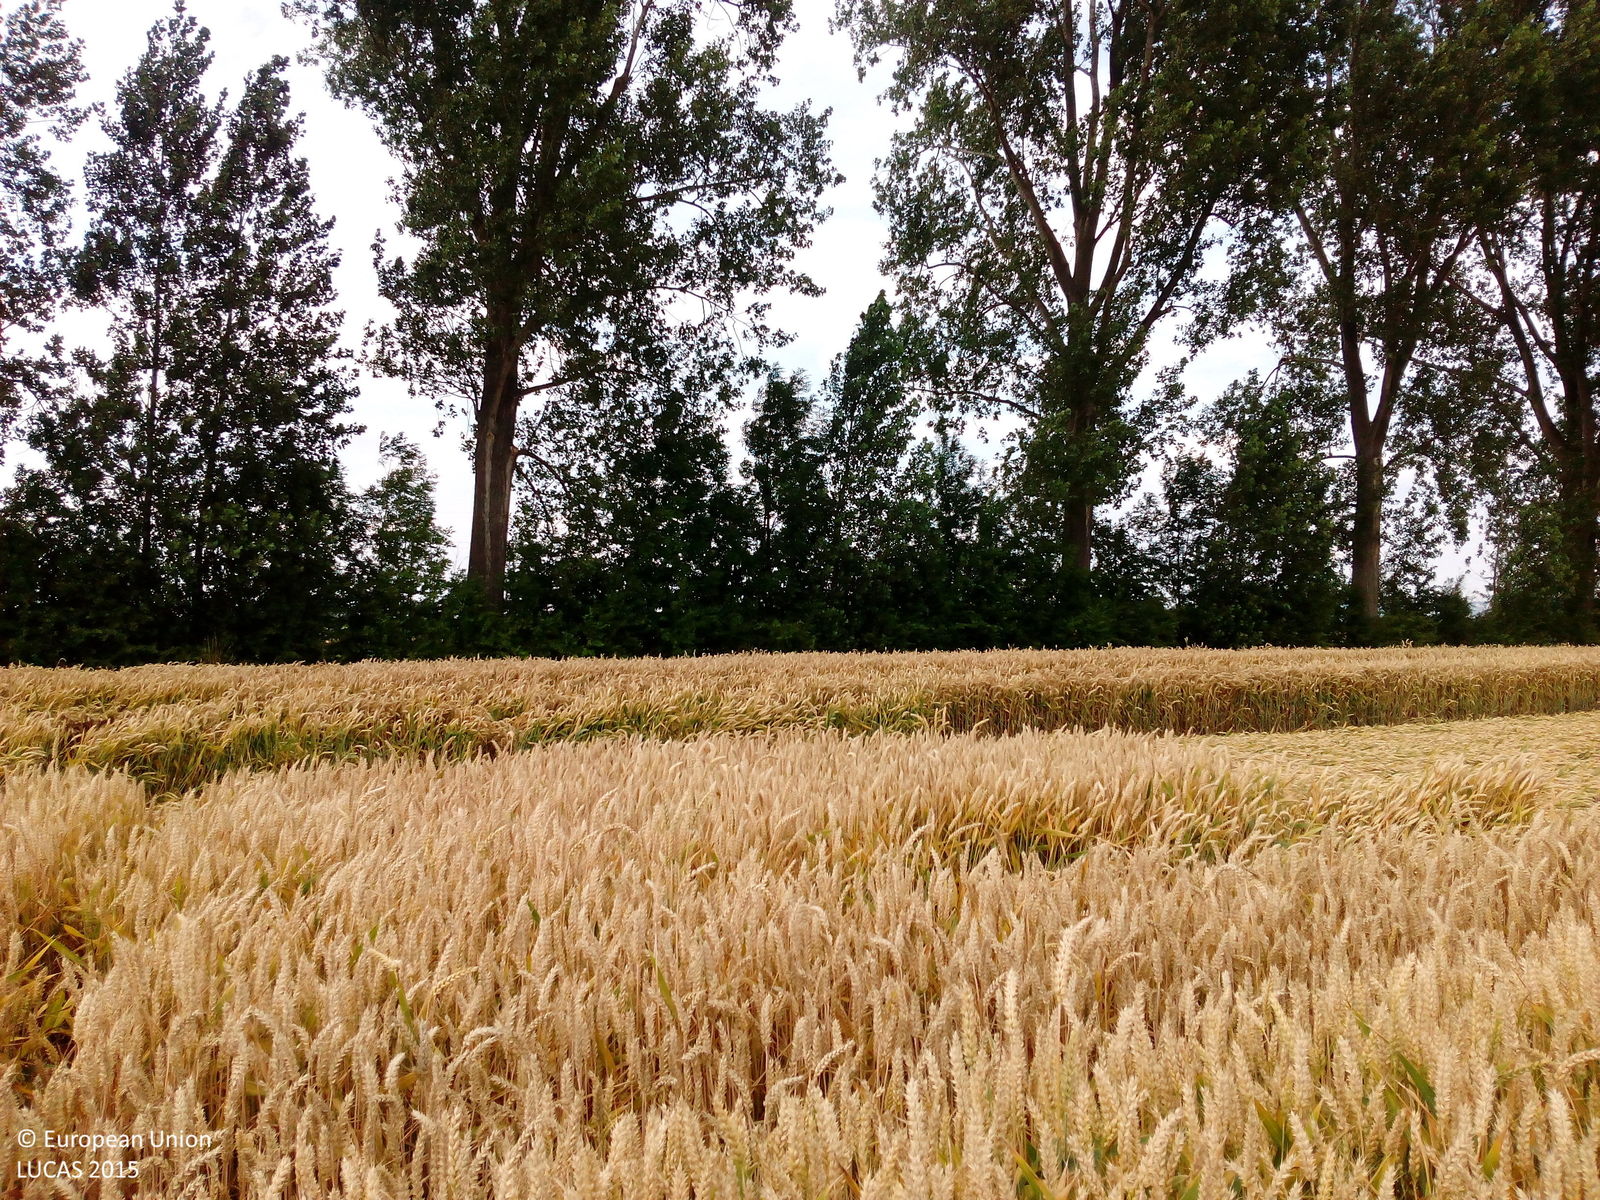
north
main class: Cropland
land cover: Common wheat
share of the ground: > 75 %
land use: Agriculture (excluding fallow land and kitchen gardens)
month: July
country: DE
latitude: 51.4786
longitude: 9.8705
